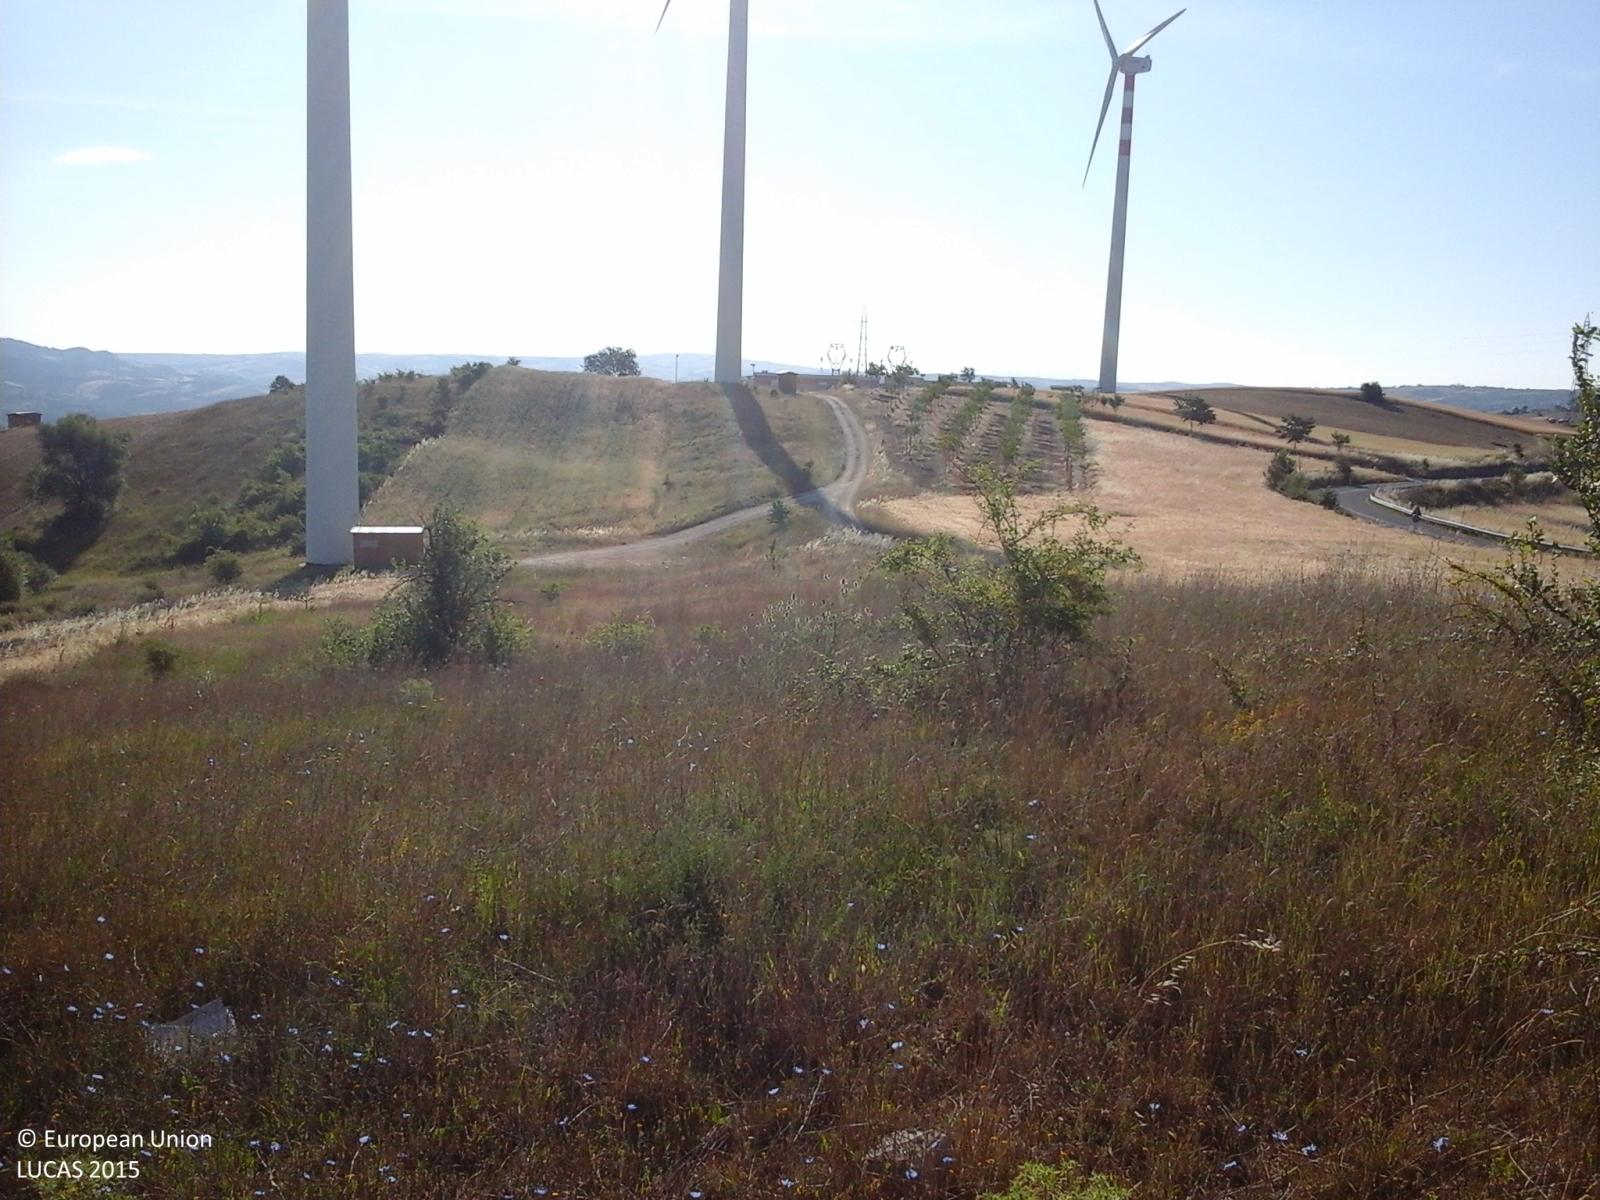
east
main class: Grassland
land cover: Grassland with sparse tree/shrub cover
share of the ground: > 75 %
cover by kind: herbaceous plants 85 %, shrubs 10 %, broadleaved forest trees 5 %
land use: Abandoned areas
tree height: < 5 m
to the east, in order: Grassland with sparse tree/shrub cover; Tracks; Nuts trees
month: June
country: IT
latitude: 40.9840
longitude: 15.1507
